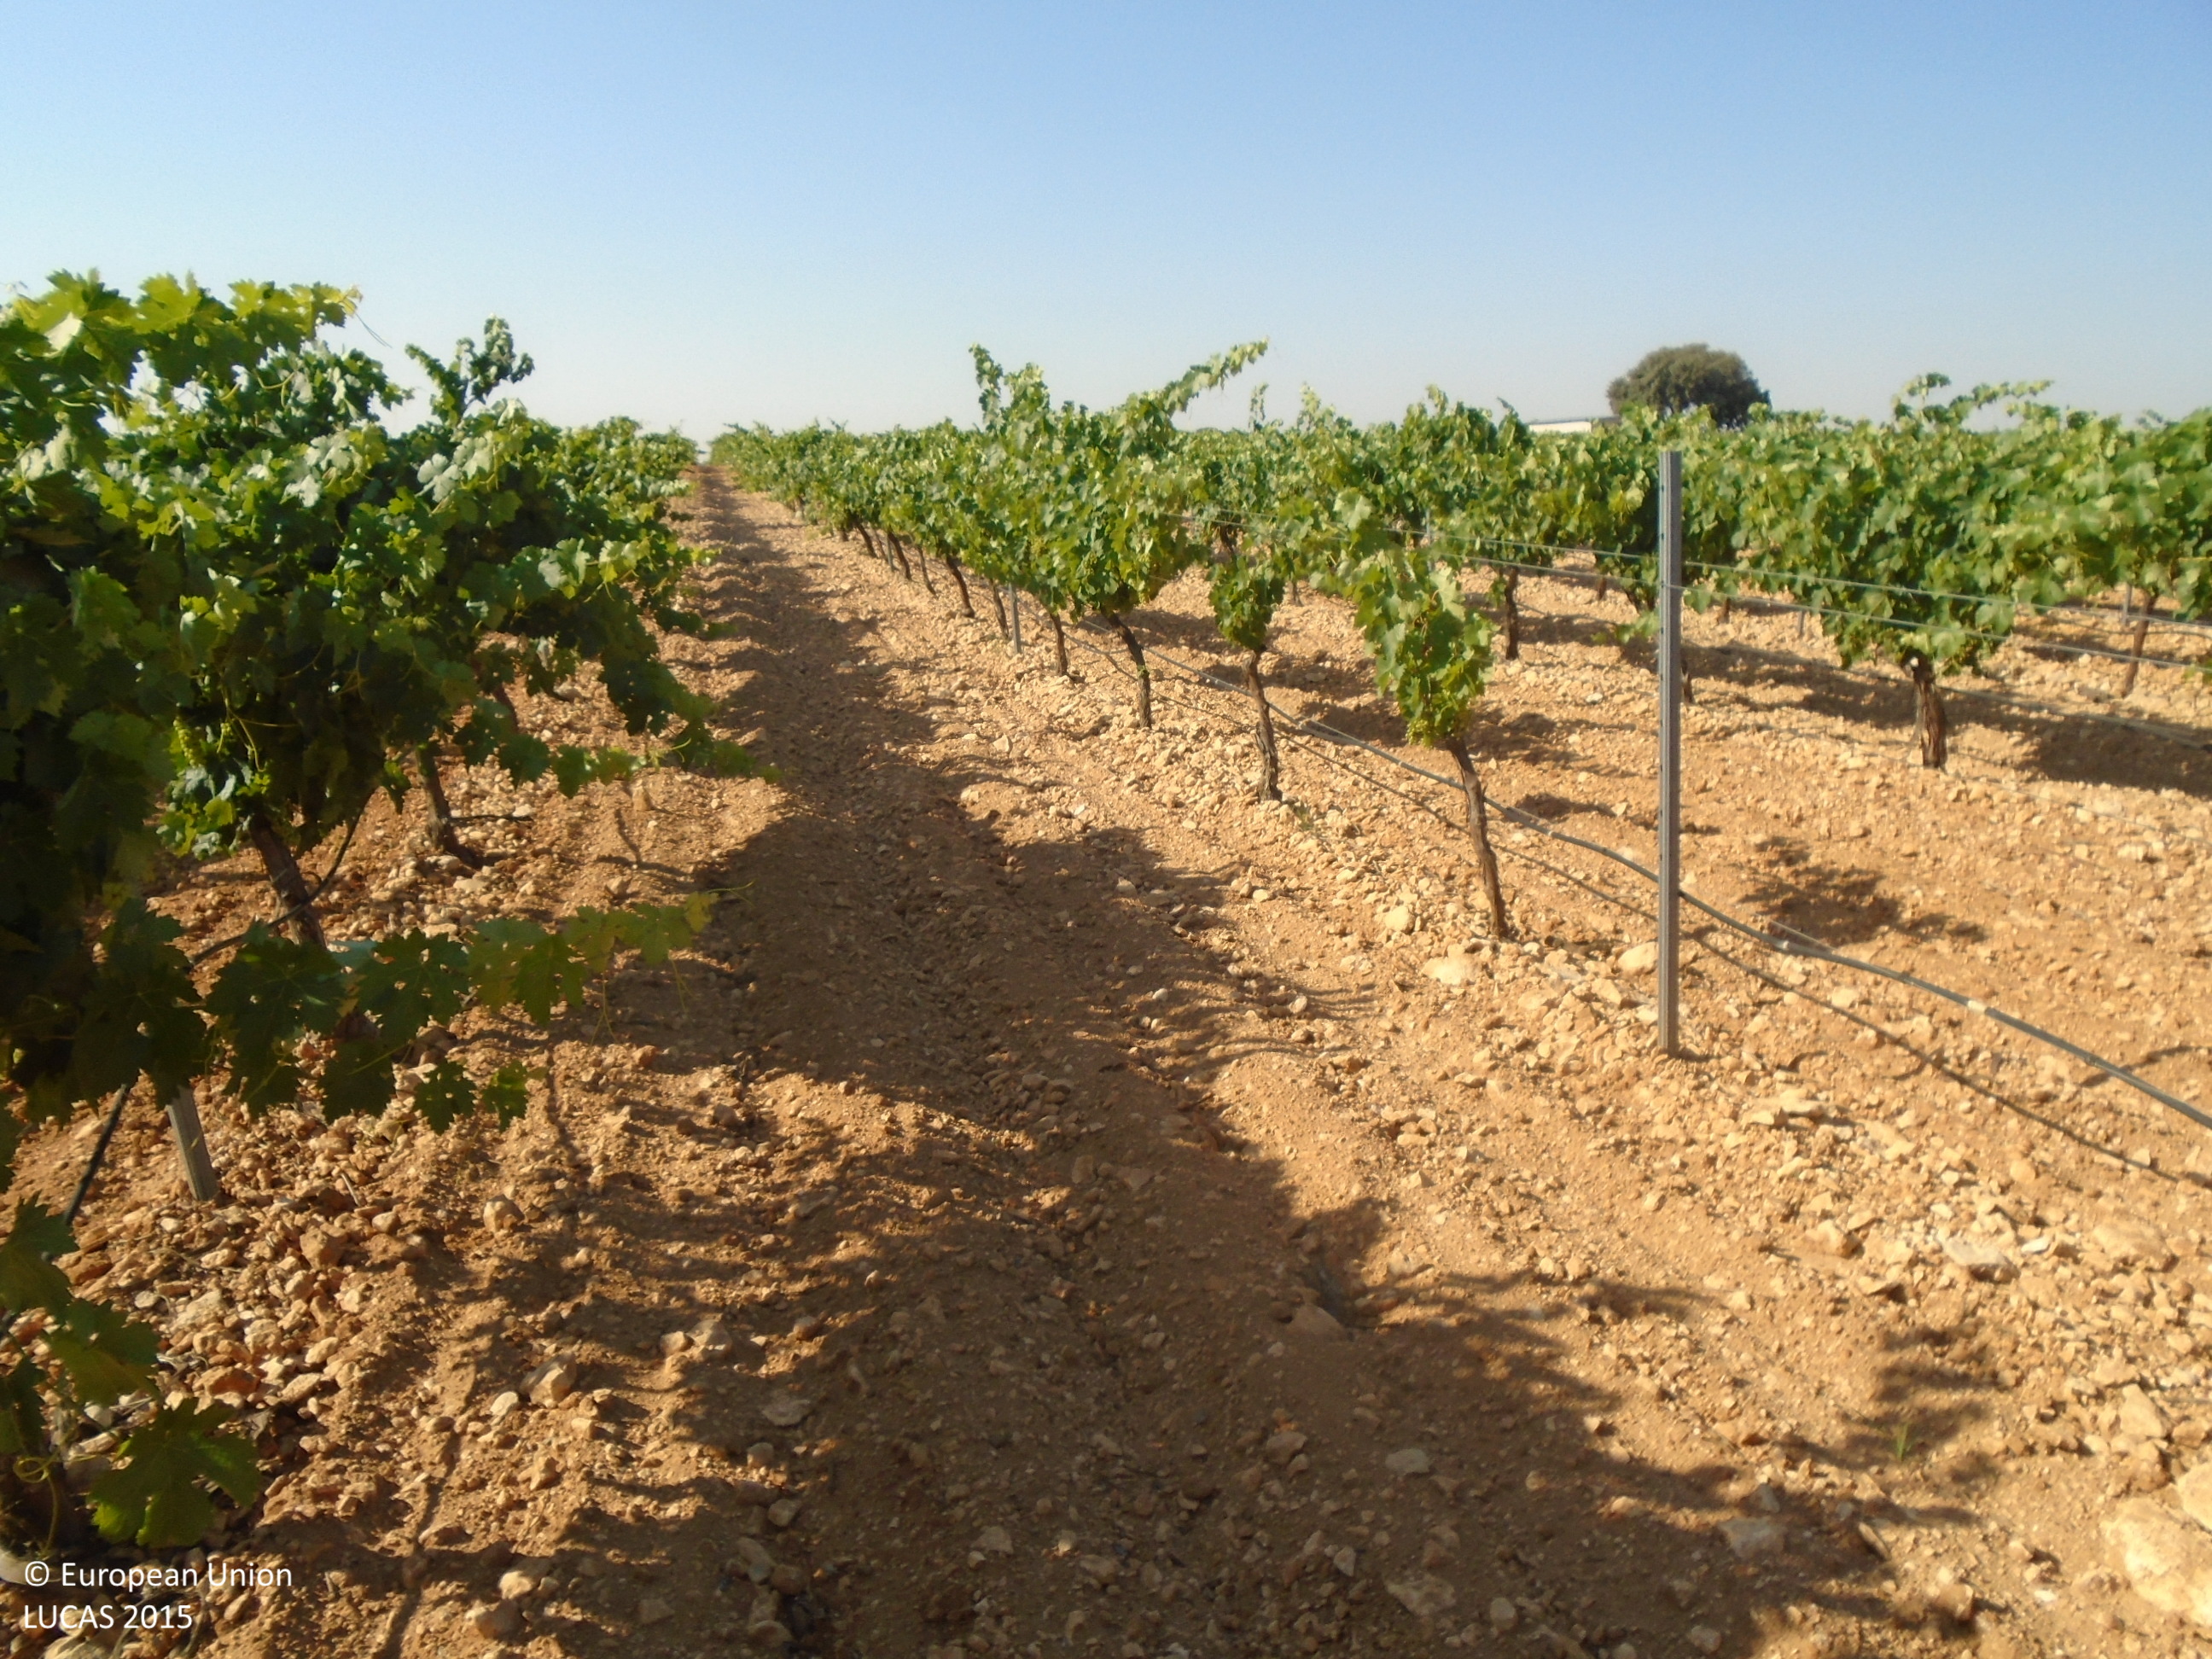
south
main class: Cropland
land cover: Vineyards
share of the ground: 10 - 25 %
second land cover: Other bare soil
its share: > 75 %
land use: Agriculture (excluding fallow land and kitchen gardens)
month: June
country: ES
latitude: 39.1937
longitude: -3.5541
